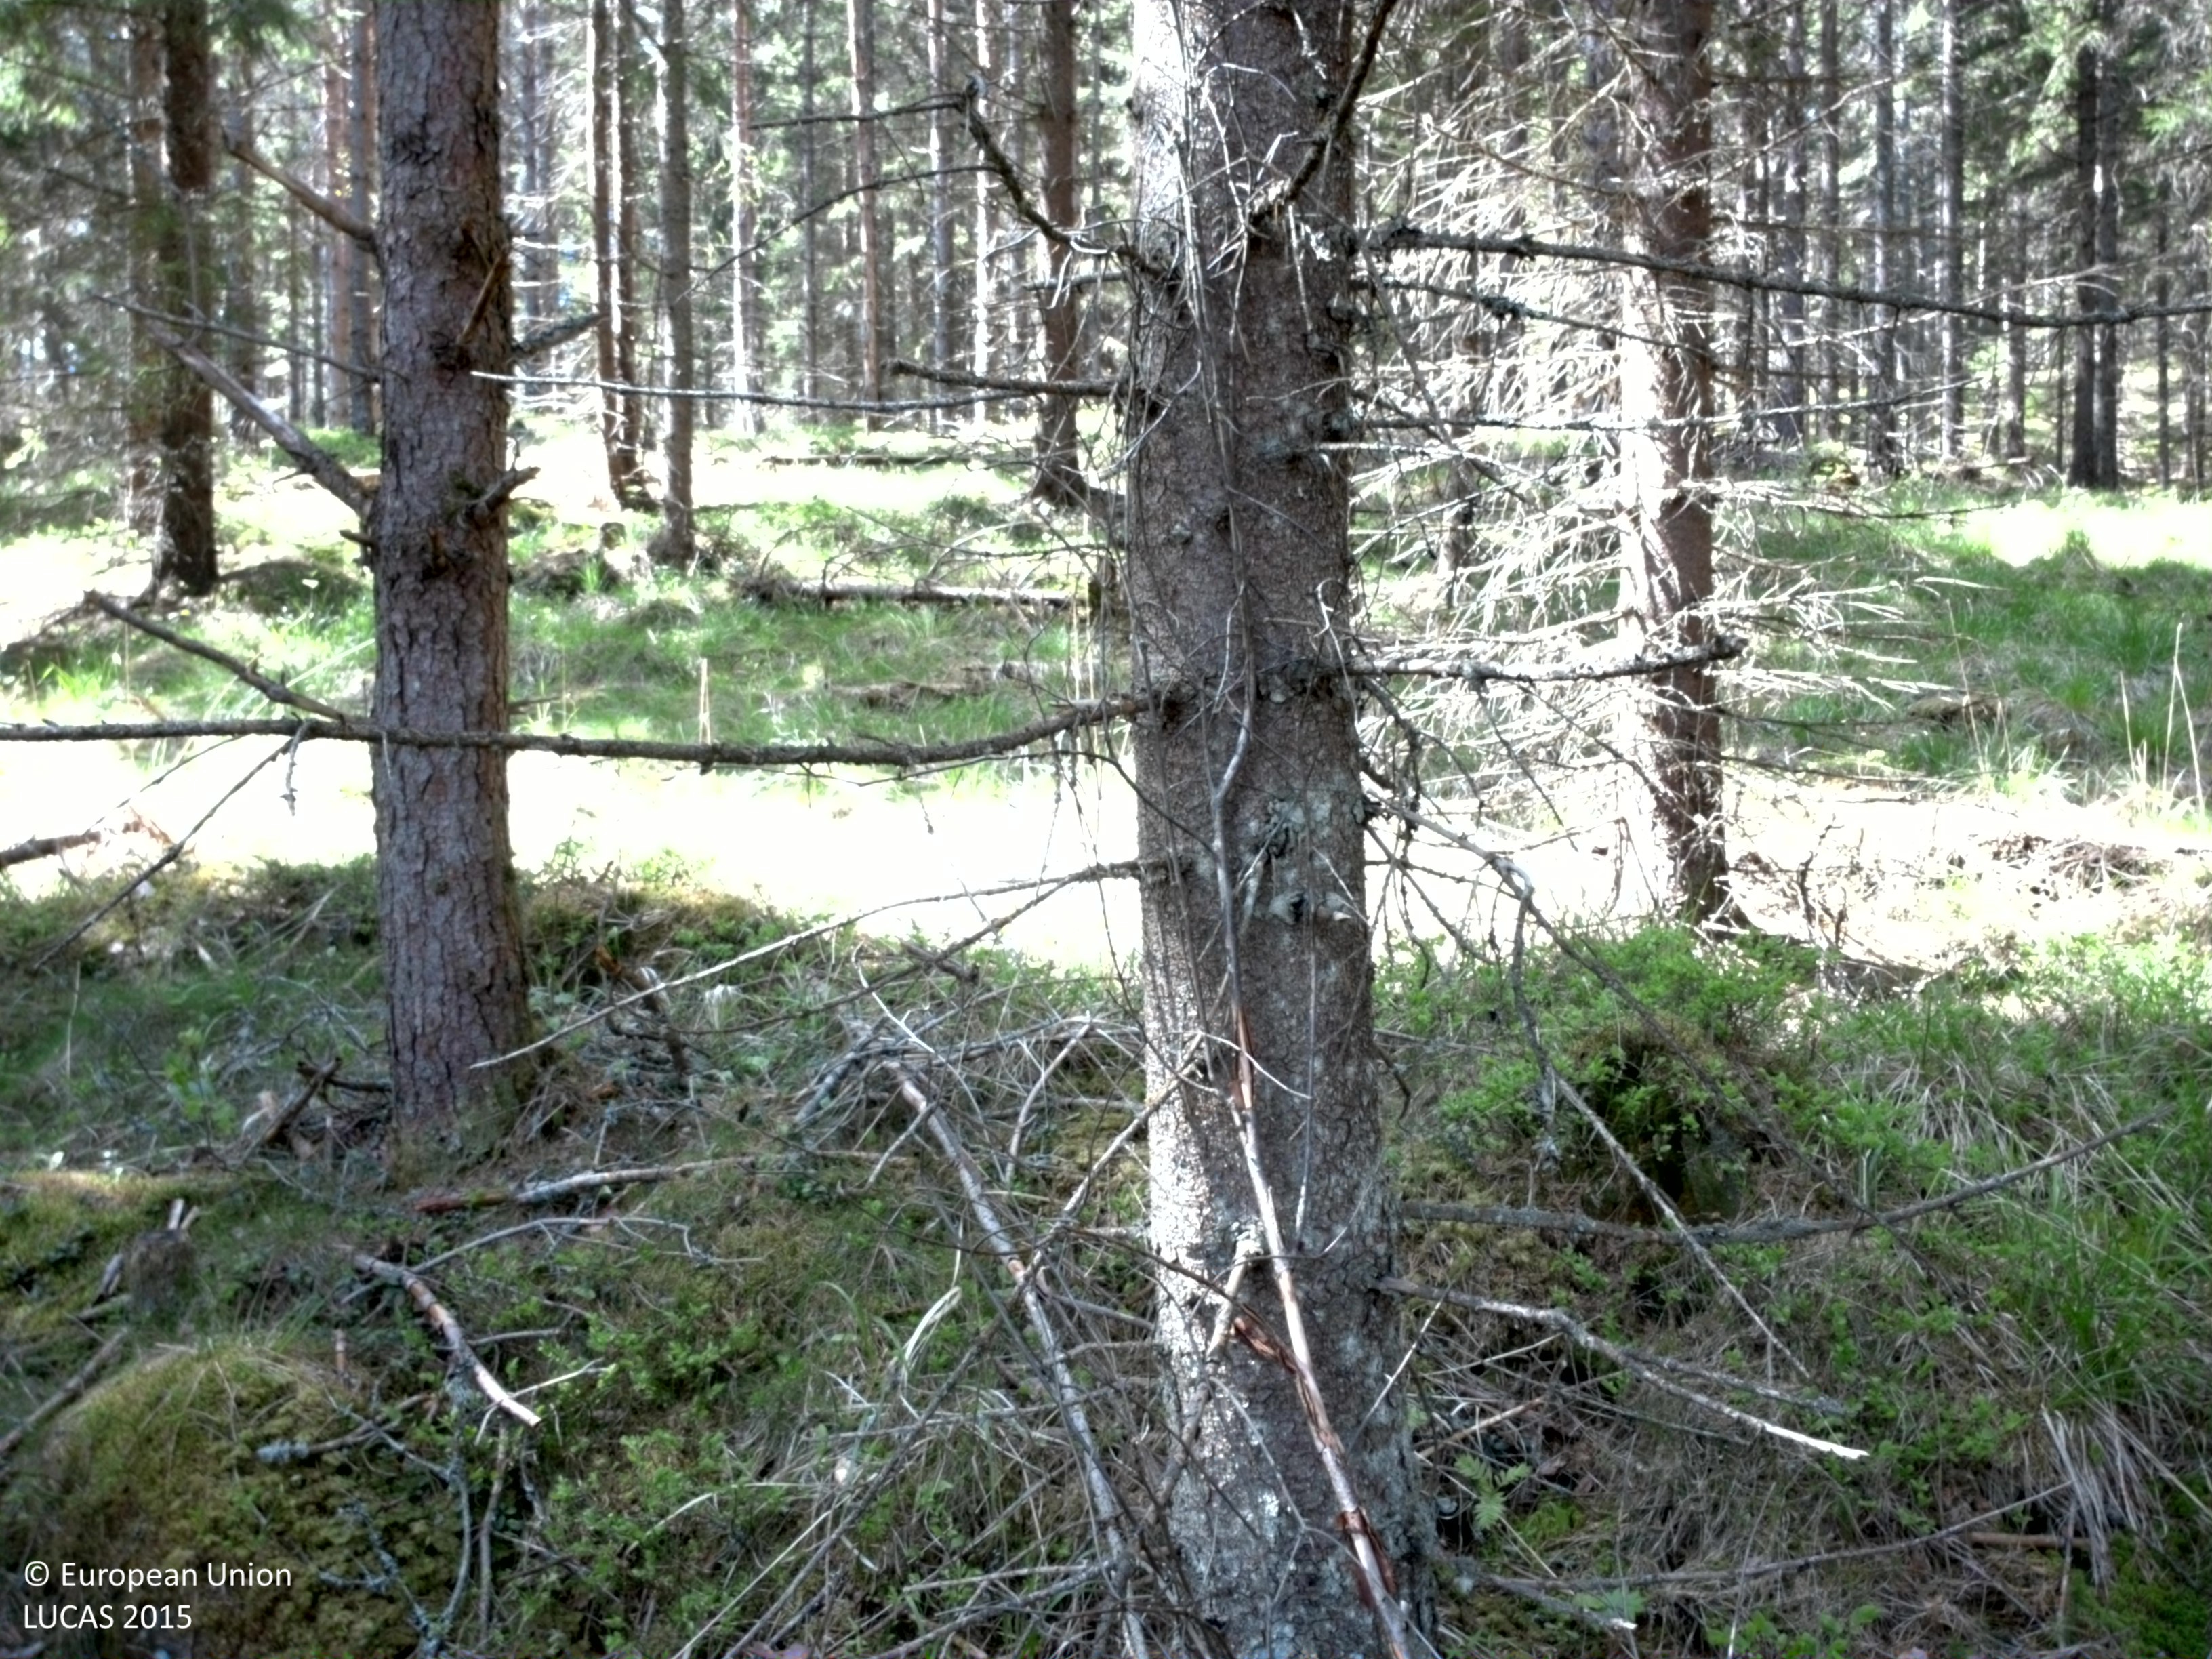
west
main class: Woodland
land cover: Spruce dominated coniferous woodland
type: boreal forest
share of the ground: > 75 %
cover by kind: coniferous forest trees 70 %, herbaceous plants 15 %, lichens and mosses 10 %, broadleaved forest trees 5 %
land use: Forestry
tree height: > 5 m
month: May
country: SE
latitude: 59.5135
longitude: 12.3090
